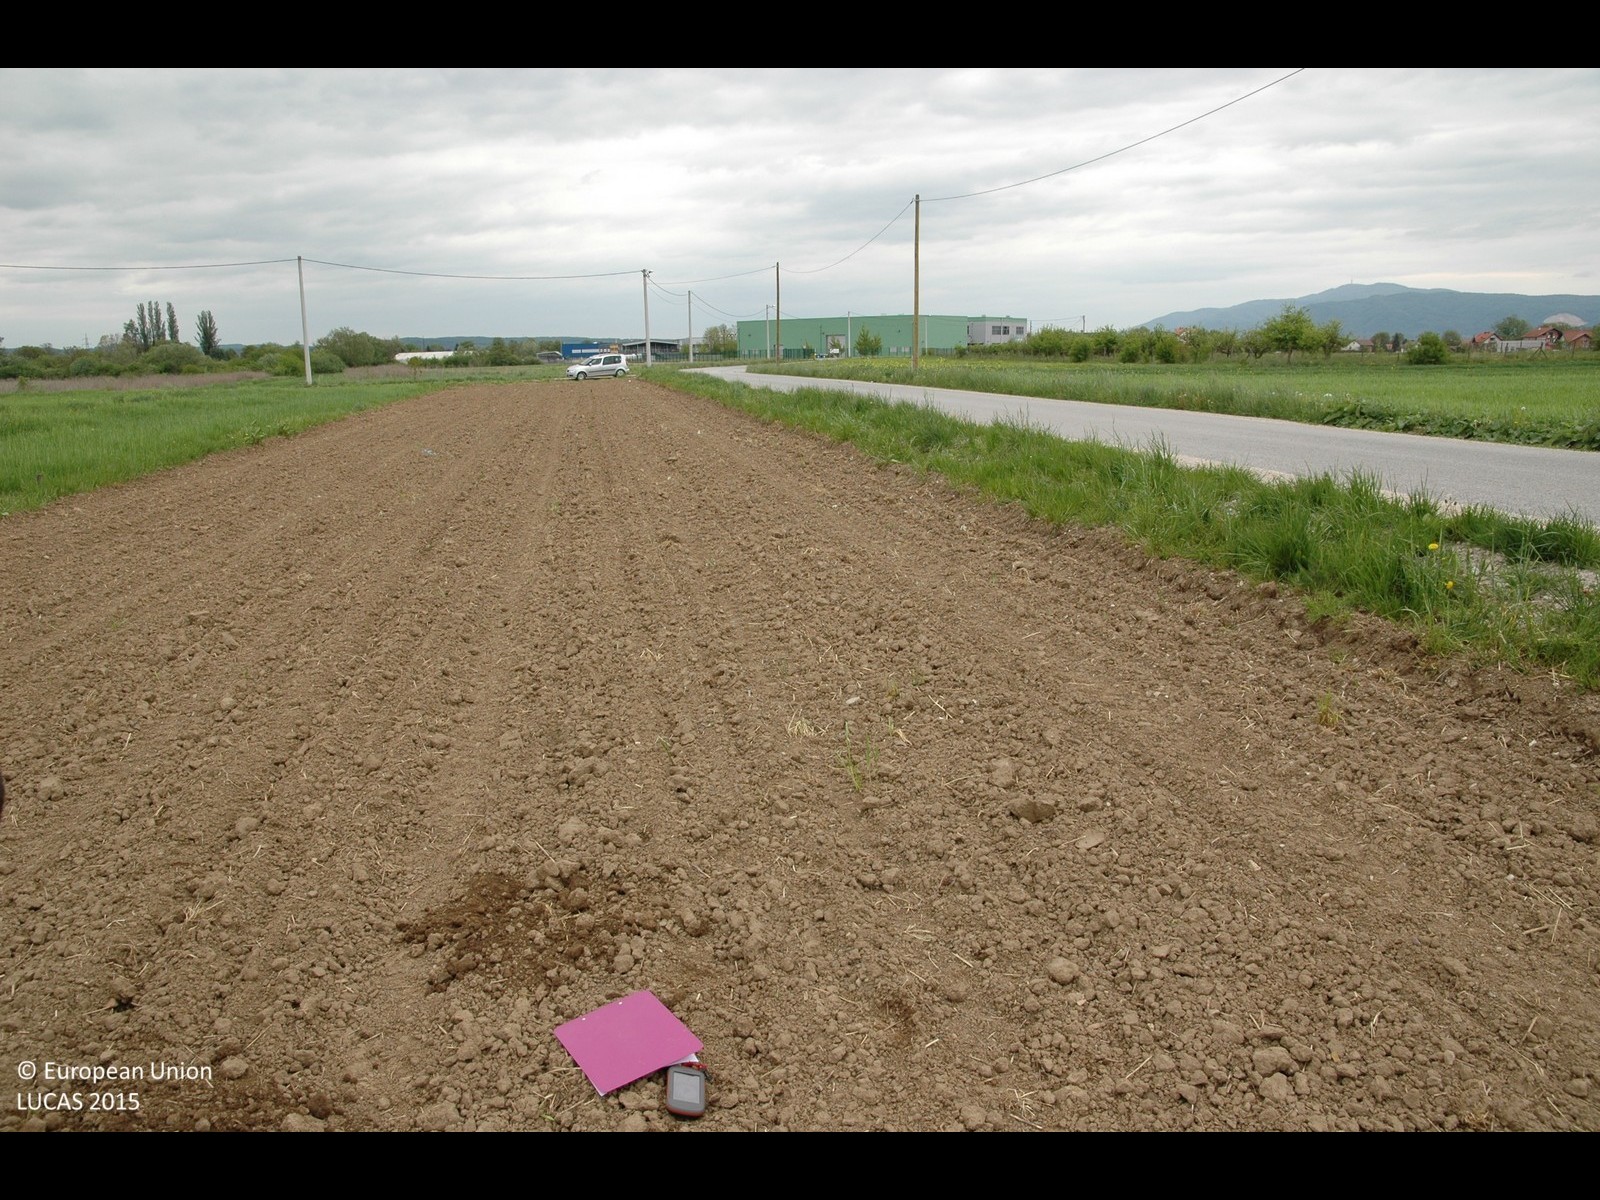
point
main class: Cropland
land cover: Maize
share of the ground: < 10 %
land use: Agriculture (excluding fallow land and kitchen gardens)
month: May
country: HR
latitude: 45.8187
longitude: 15.7248
